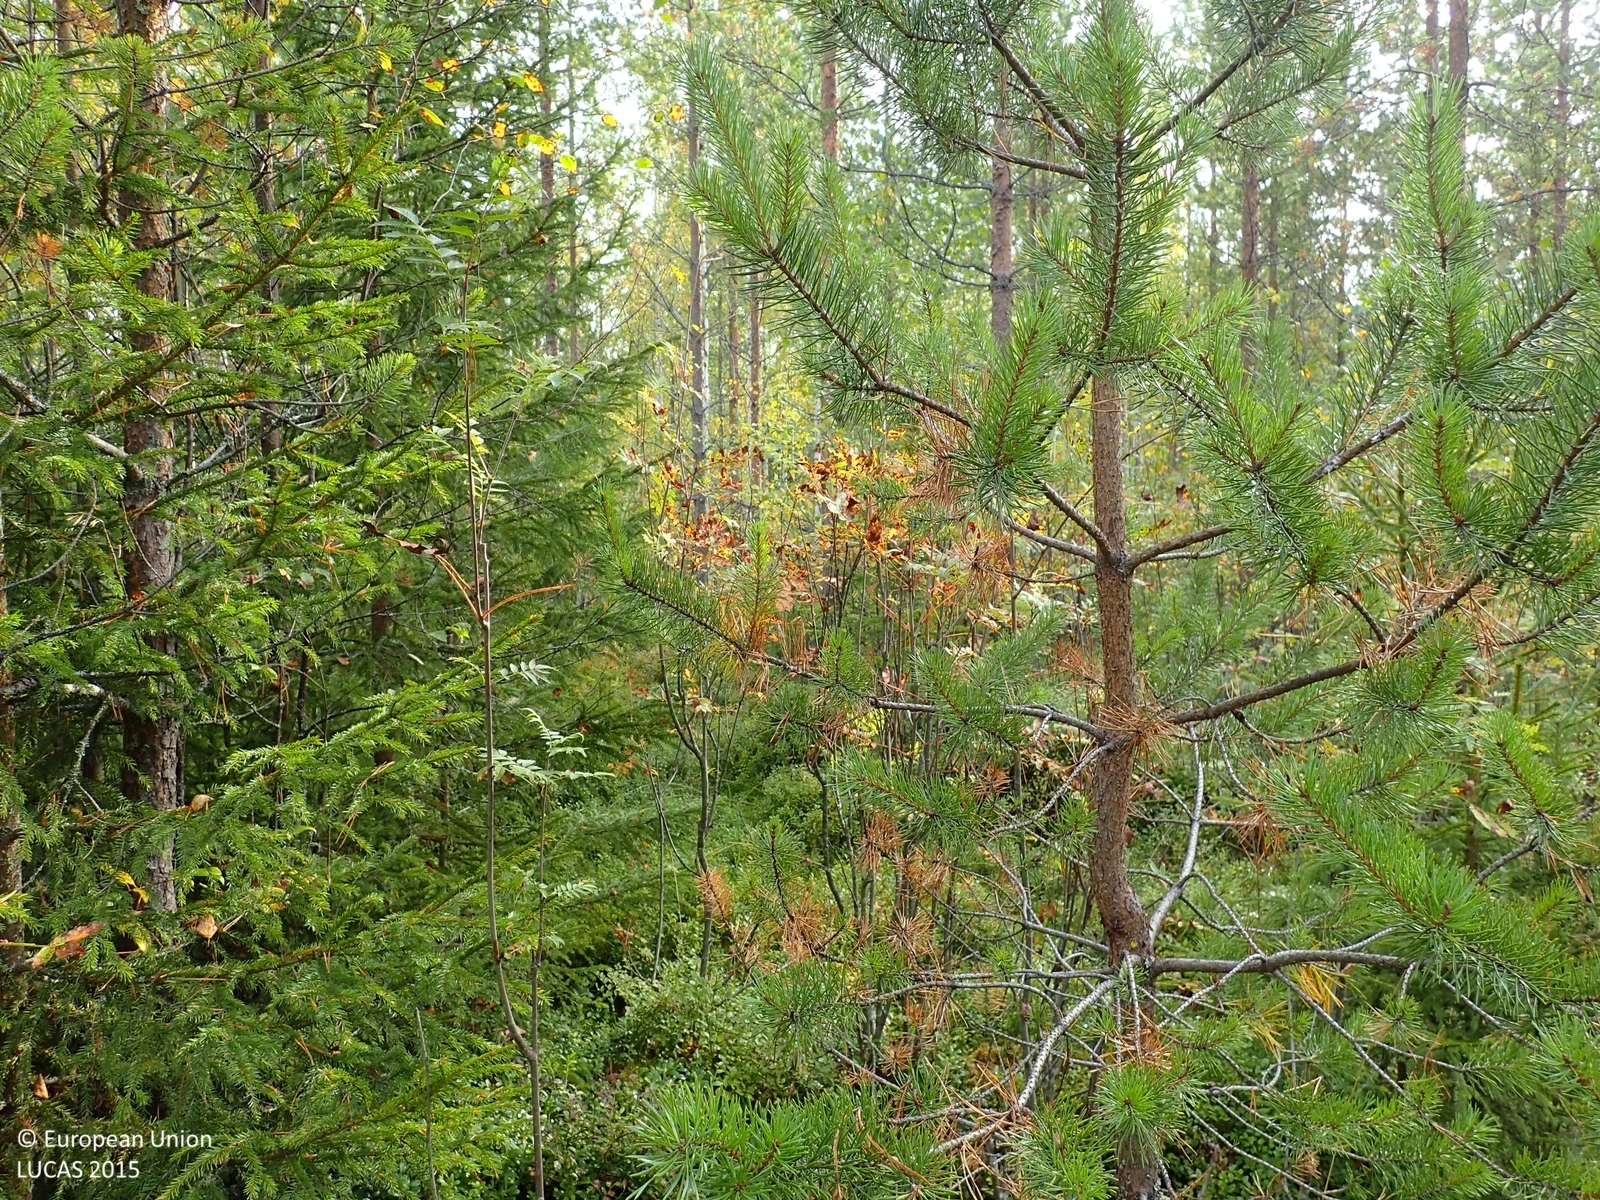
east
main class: Woodland
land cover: Pine dominated mixed woodland
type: boreal forest
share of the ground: > 75 %
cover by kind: coniferous forest trees 50 %, broadleaved forest trees 30 %, shrubs 20 %
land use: Forestry
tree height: < 5 m
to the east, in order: Pine dominated mixed woodland; Spruce dominated mixed woodland; Ditches and canals; Spruce dominated mixed woodland
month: September
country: FI
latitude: 63.1553
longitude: 25.9762
